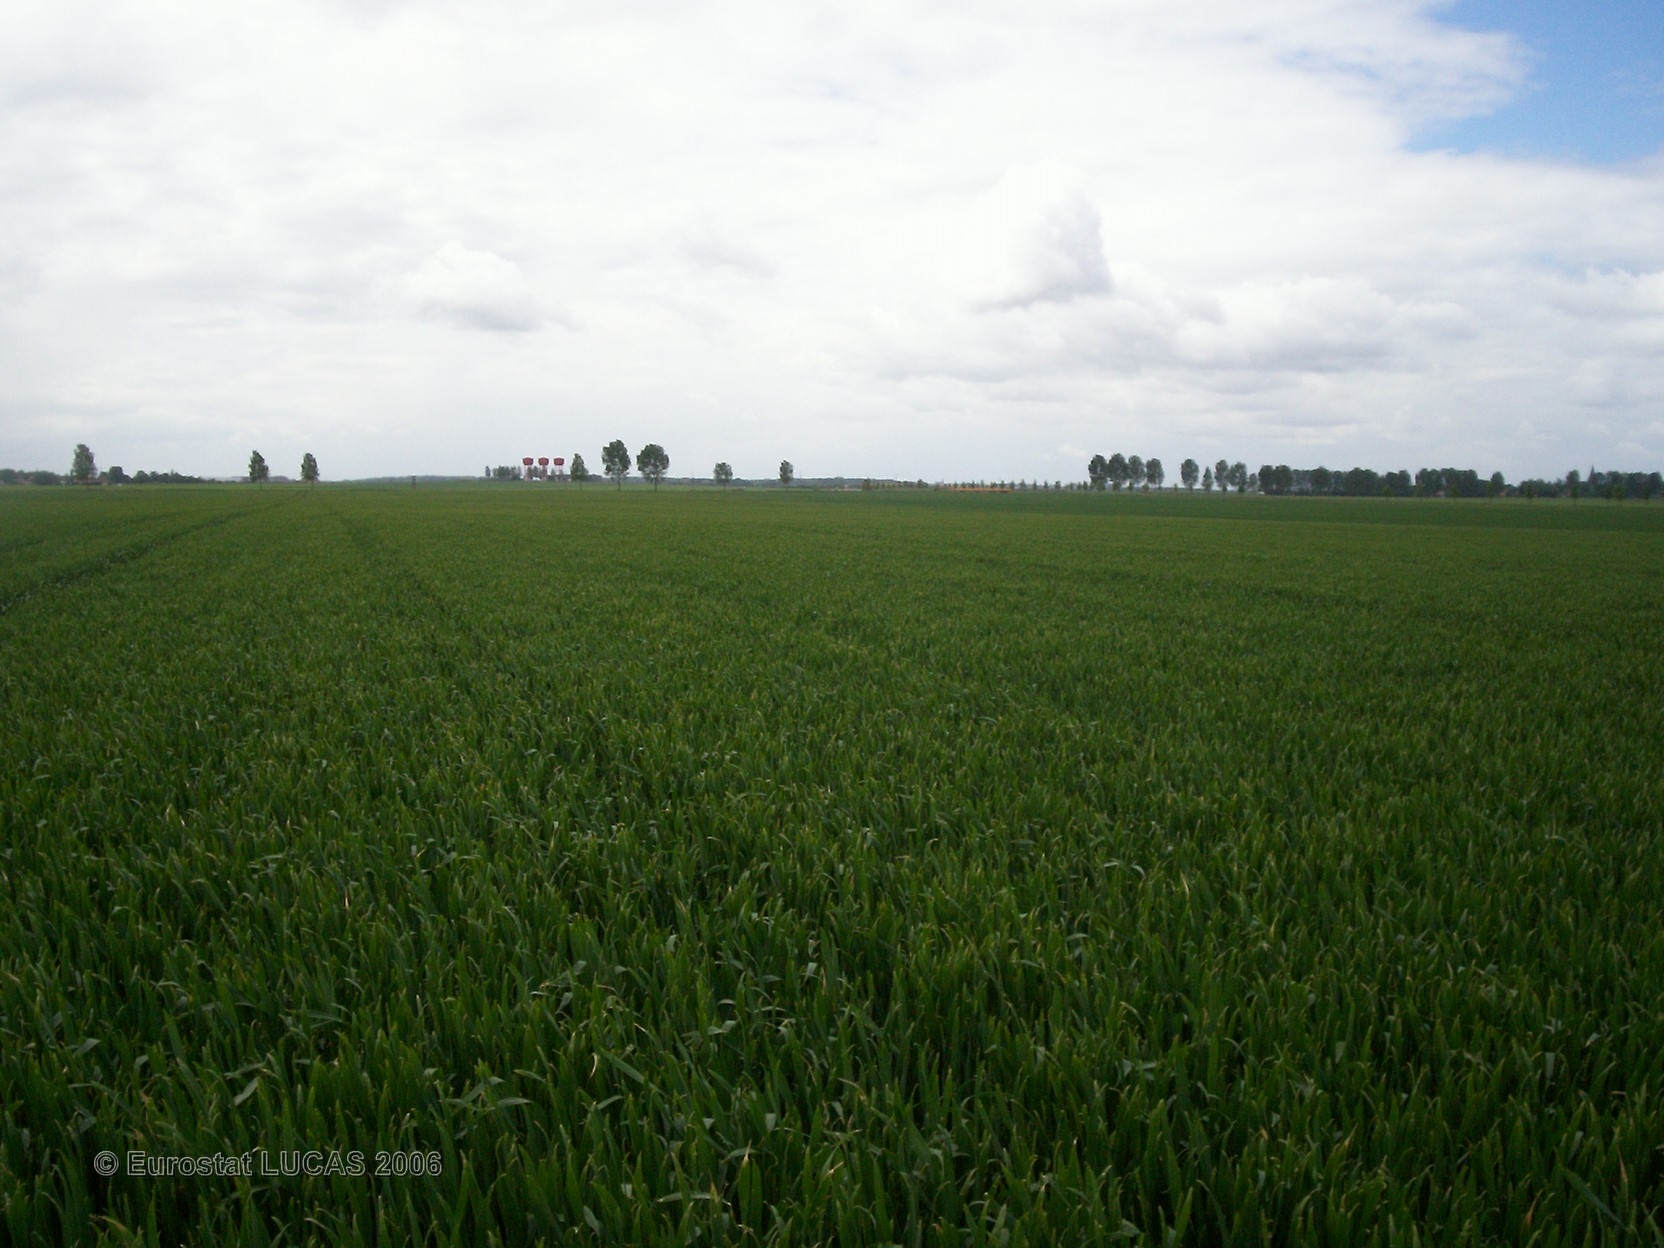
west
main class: Cropland
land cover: Common wheat
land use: Agriculture (excluding fallow land and kitchen gardens)
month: May
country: FR
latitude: 49.8571
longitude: 2.6581
